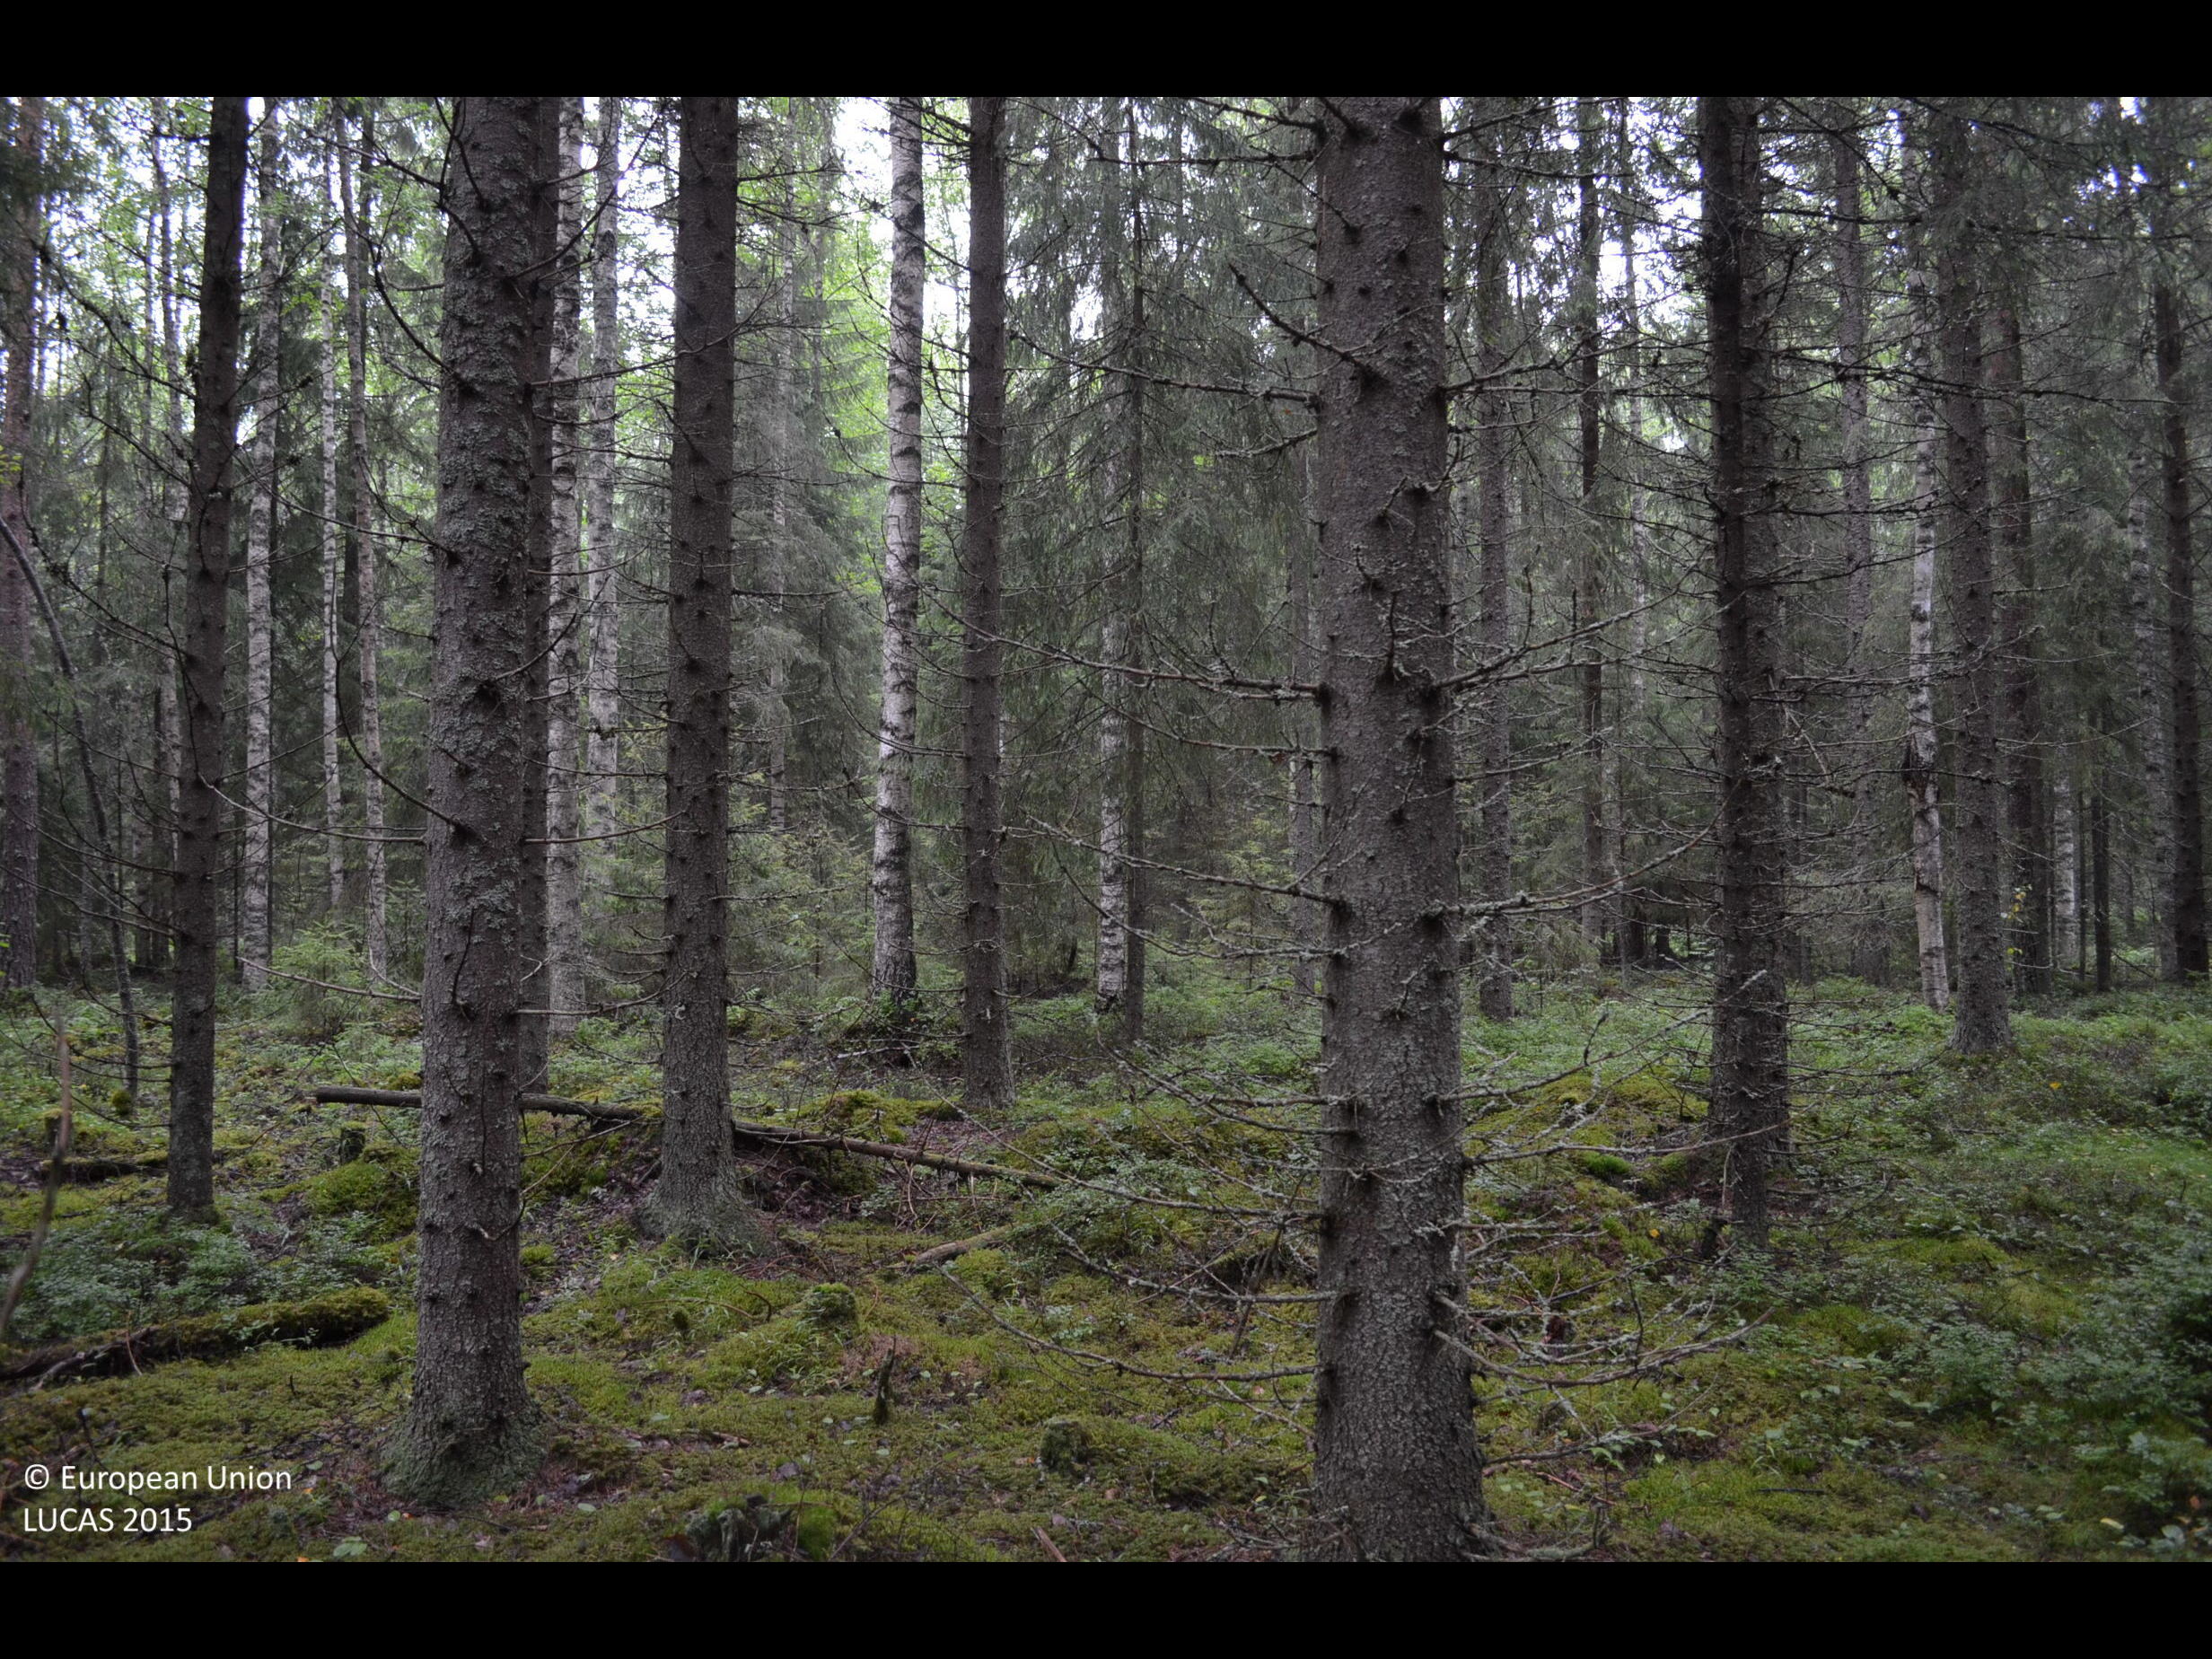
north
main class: Woodland
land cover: Spruce dominated mixed woodland
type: boreal forest
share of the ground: > 75 %
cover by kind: broadleaved forest trees 60 %, coniferous forest trees 30 %, shrubs 5 %, lichens and mosses 5 %
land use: Forestry
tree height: > 5 m
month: July
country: FI
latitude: 62.0082
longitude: 24.0076
